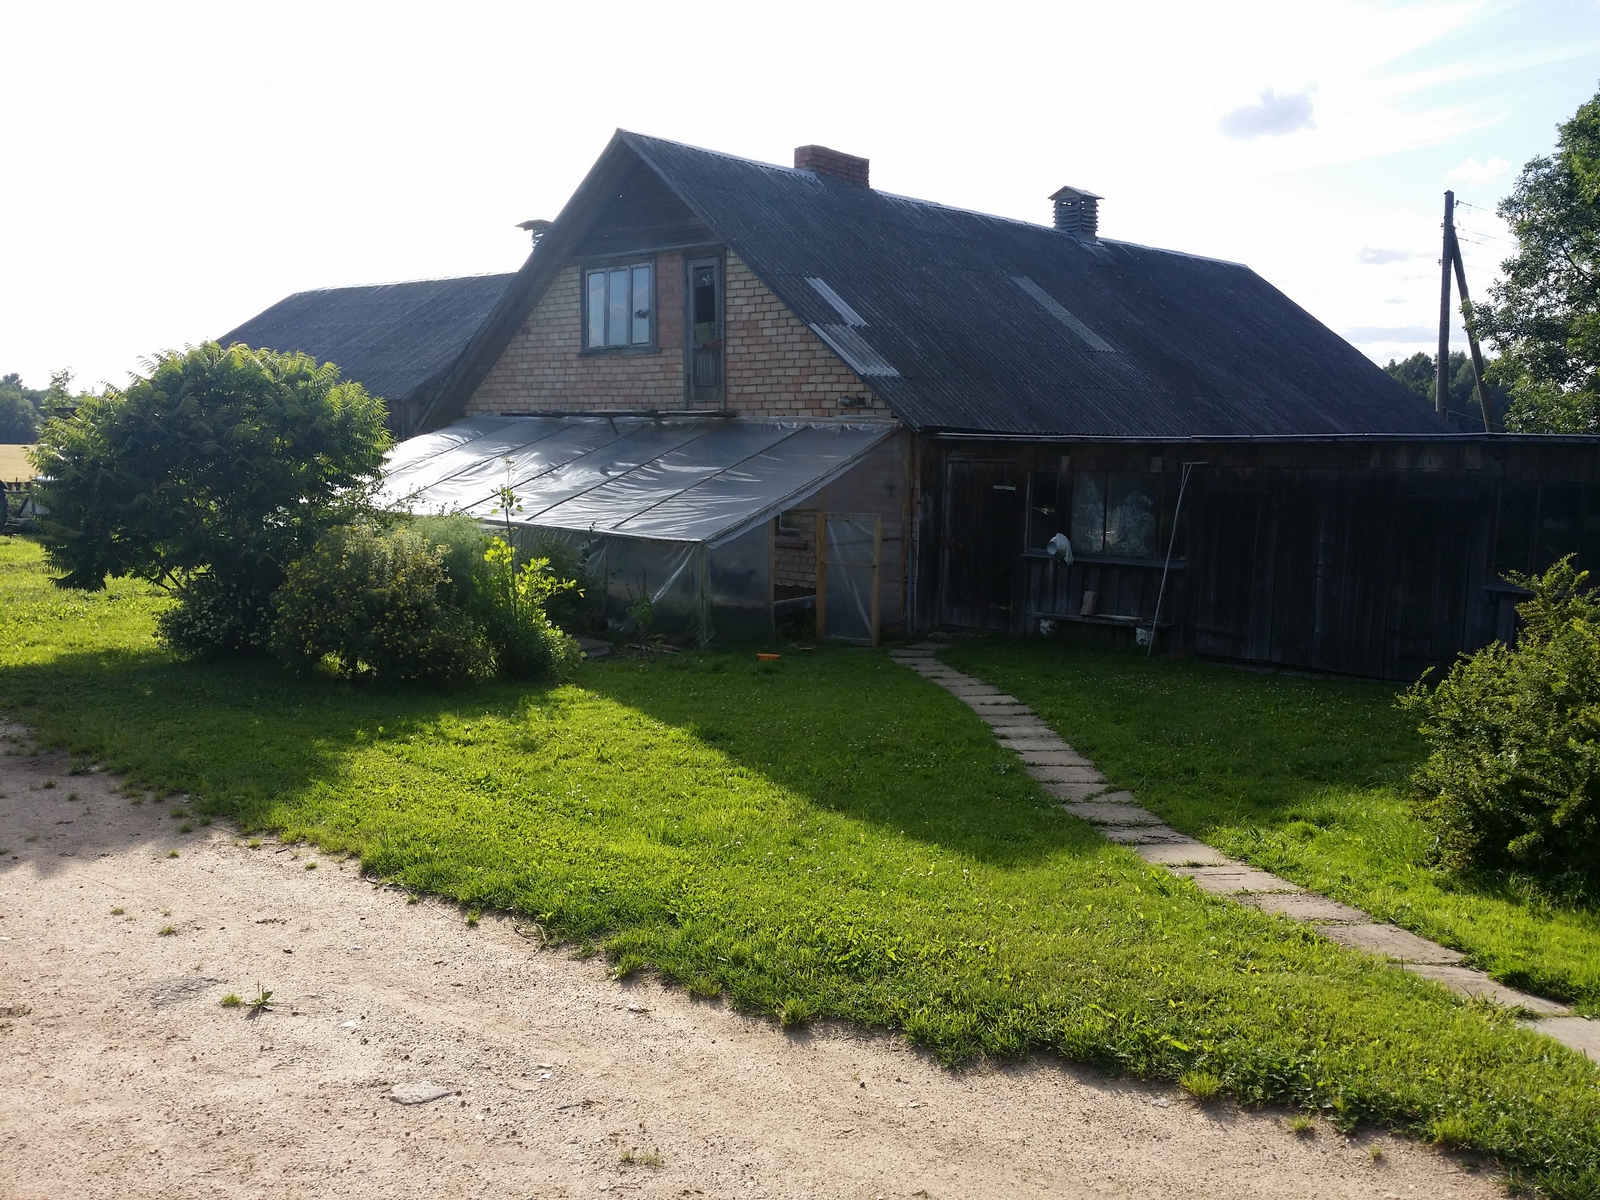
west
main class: Grassland
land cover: Grassland without tree/shrub cover
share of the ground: > 75 %
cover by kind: herbaceous plants 100 %
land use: Residential
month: July
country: LV
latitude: 57.1818
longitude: 27.2572
